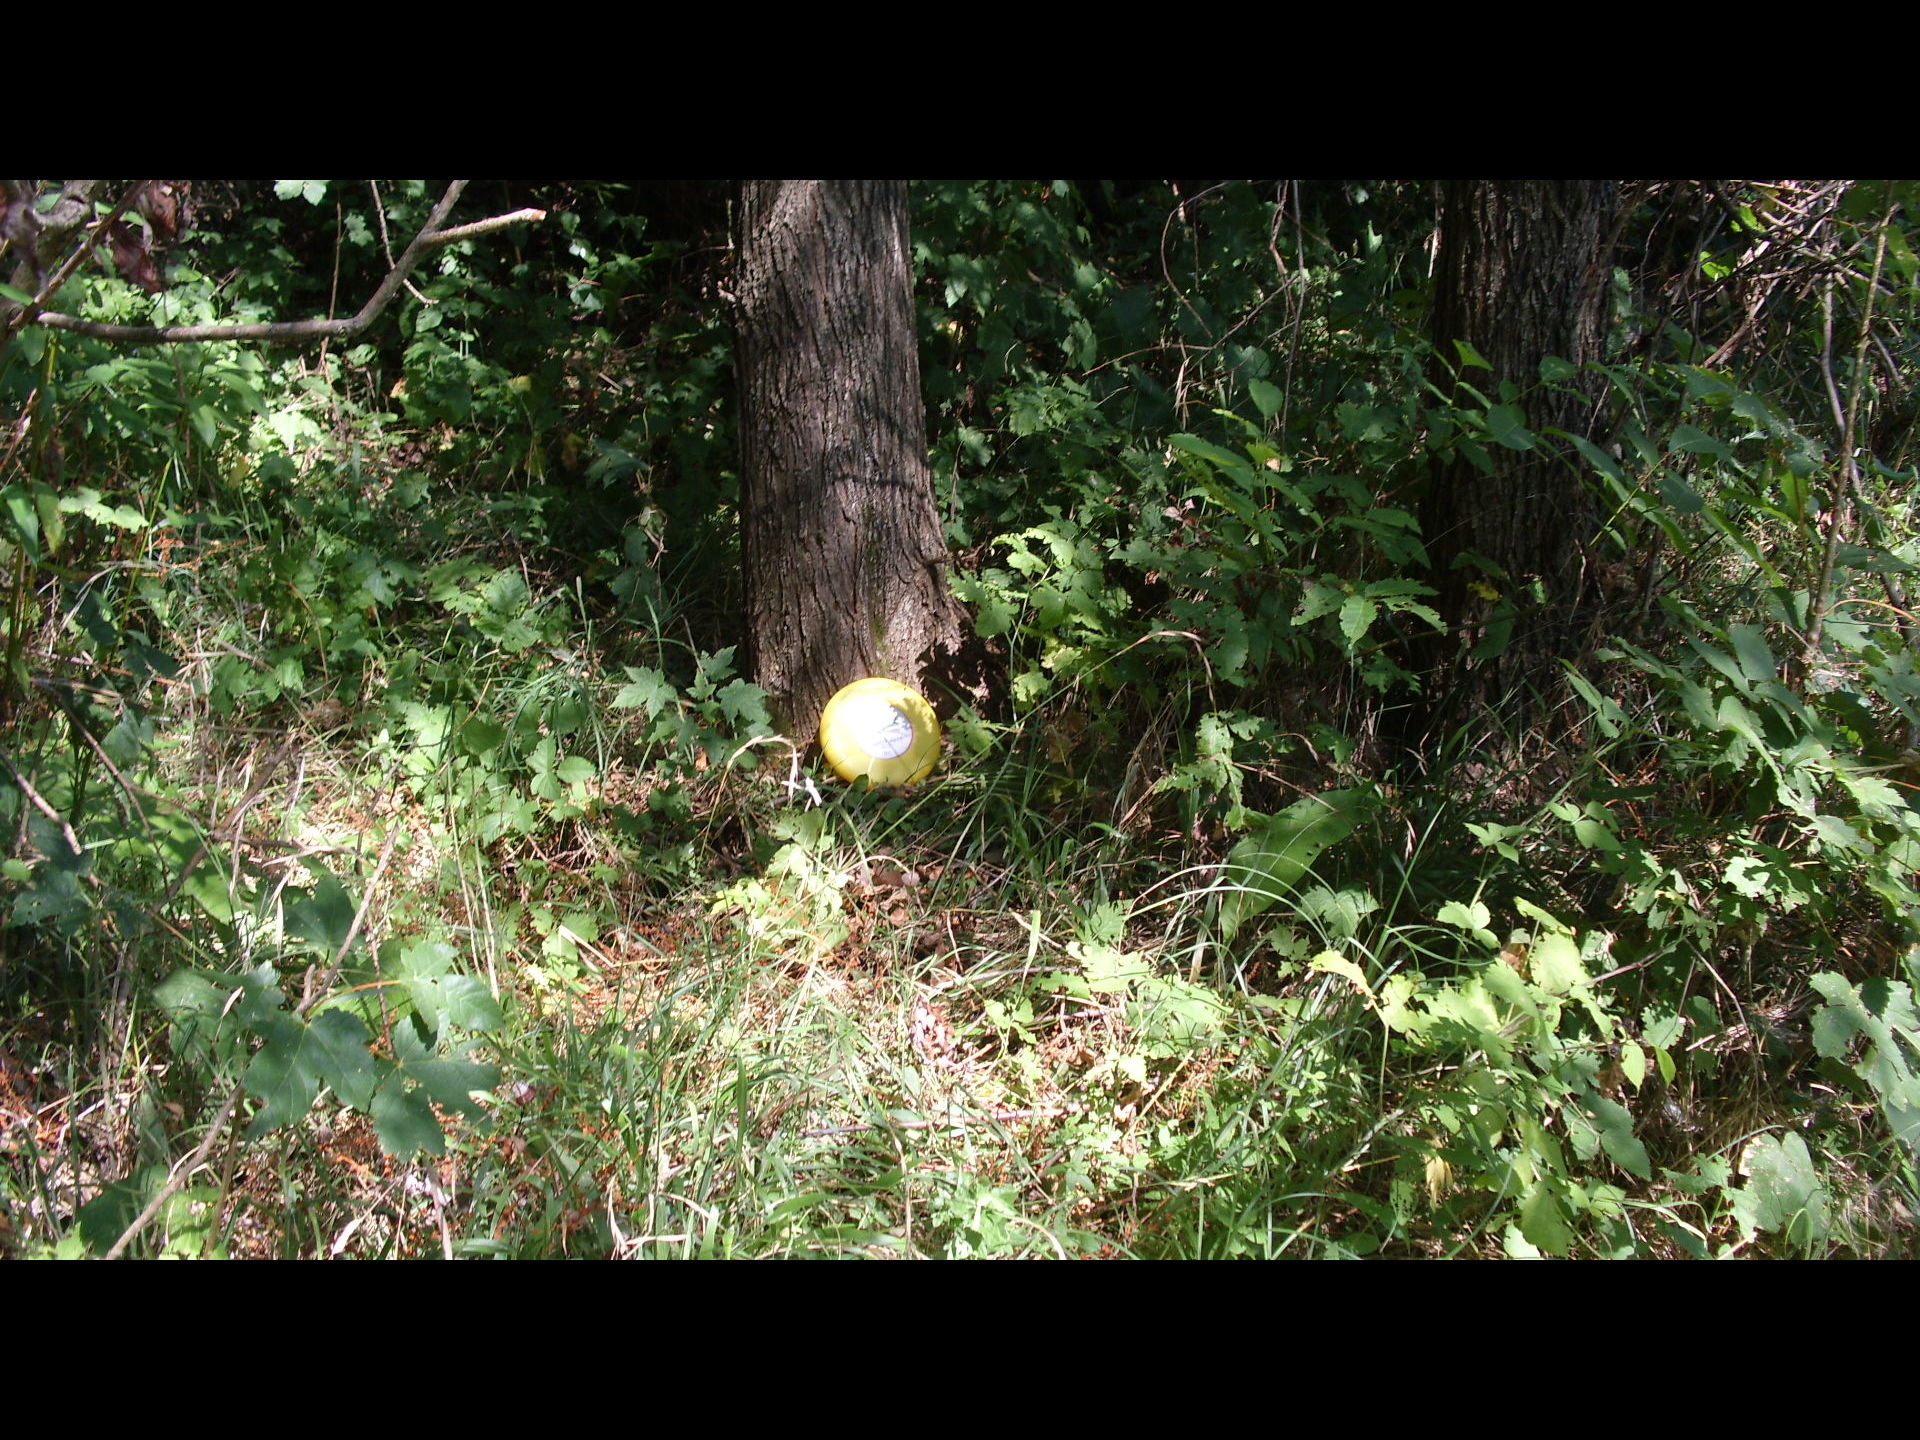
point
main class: Woodland
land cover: Broadleaved woodland
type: thermophilous deciduous forest
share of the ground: > 75 %
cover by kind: broadleaved forest trees 60 %, shrubs 30 %, herbaceous plants 10 %
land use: Forestry
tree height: > 5 m
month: August
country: BG
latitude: 43.2747
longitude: 23.4103
